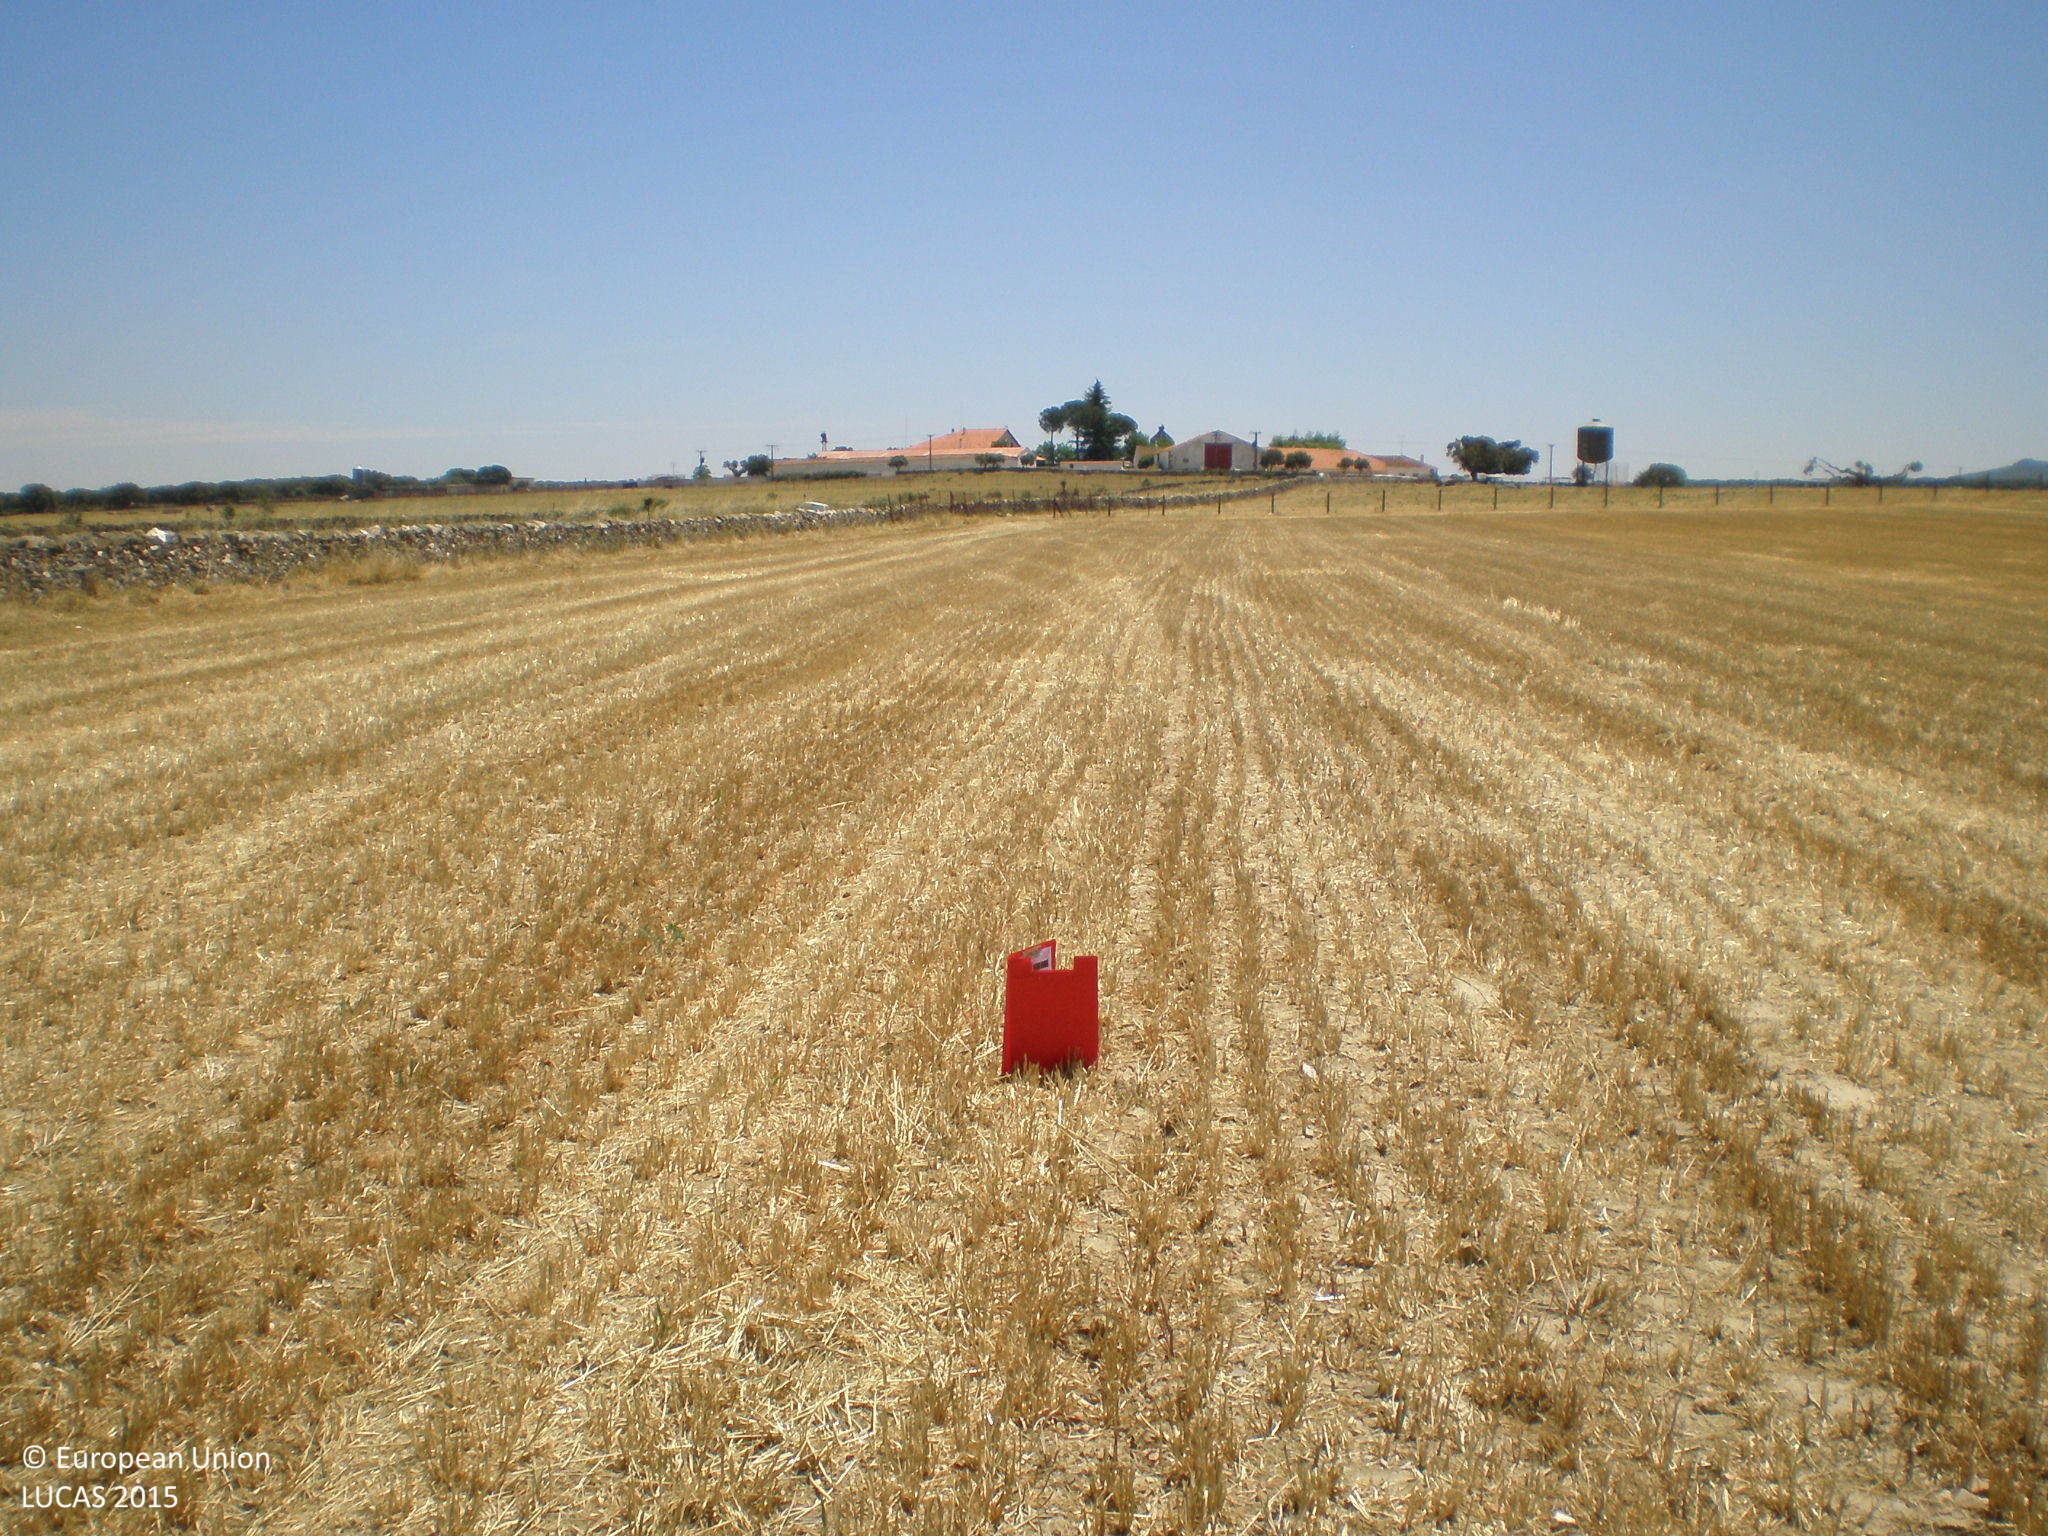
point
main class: Cropland
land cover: Oats
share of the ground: < 10 %
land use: Agriculture (excluding fallow land and kitchen gardens)
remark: Harvested field
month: June
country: ES
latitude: 40.7547
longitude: -5.8430
